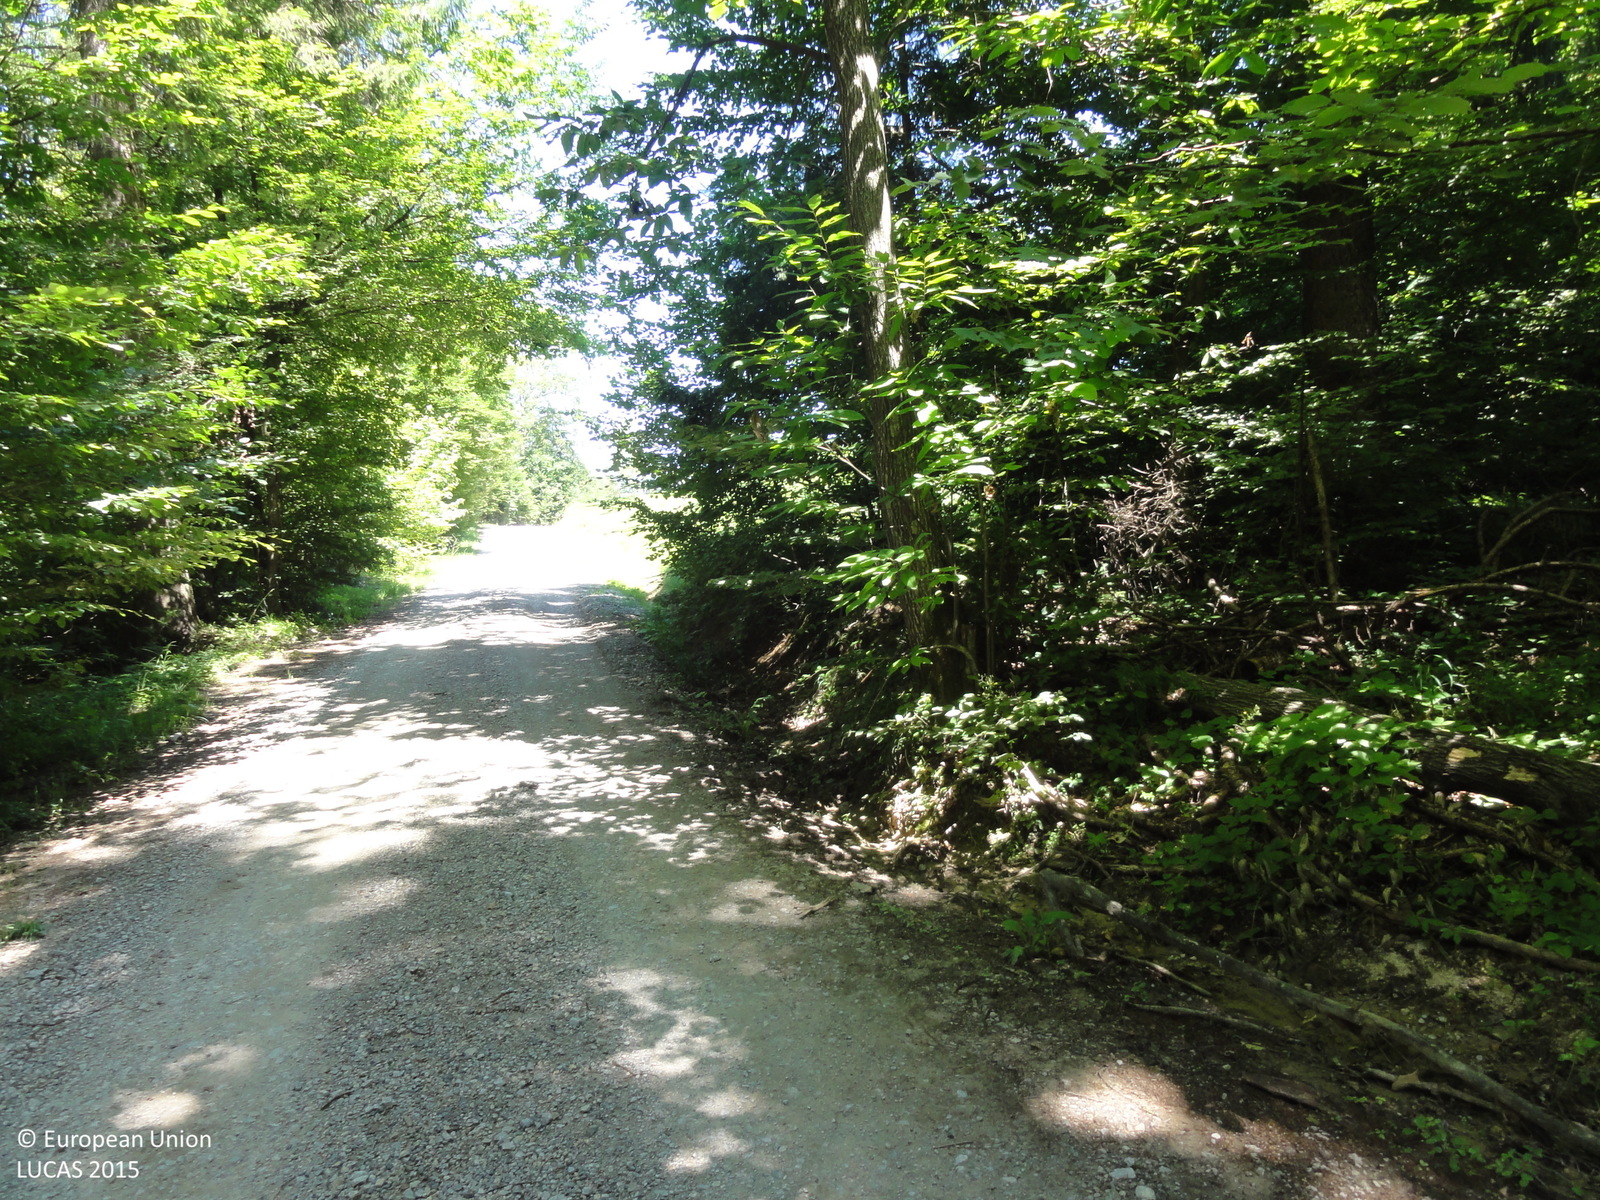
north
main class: Woodland
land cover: Spruce dominated mixed woodland
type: mountainous beech forest
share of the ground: > 75 %
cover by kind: coniferous forest trees 60 %, broadleaved forest trees 35 %, unconsolidated bare surface 5 %
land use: Forestry
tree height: > 5 m
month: July
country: SI
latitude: 46.3030
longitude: 15.0741
